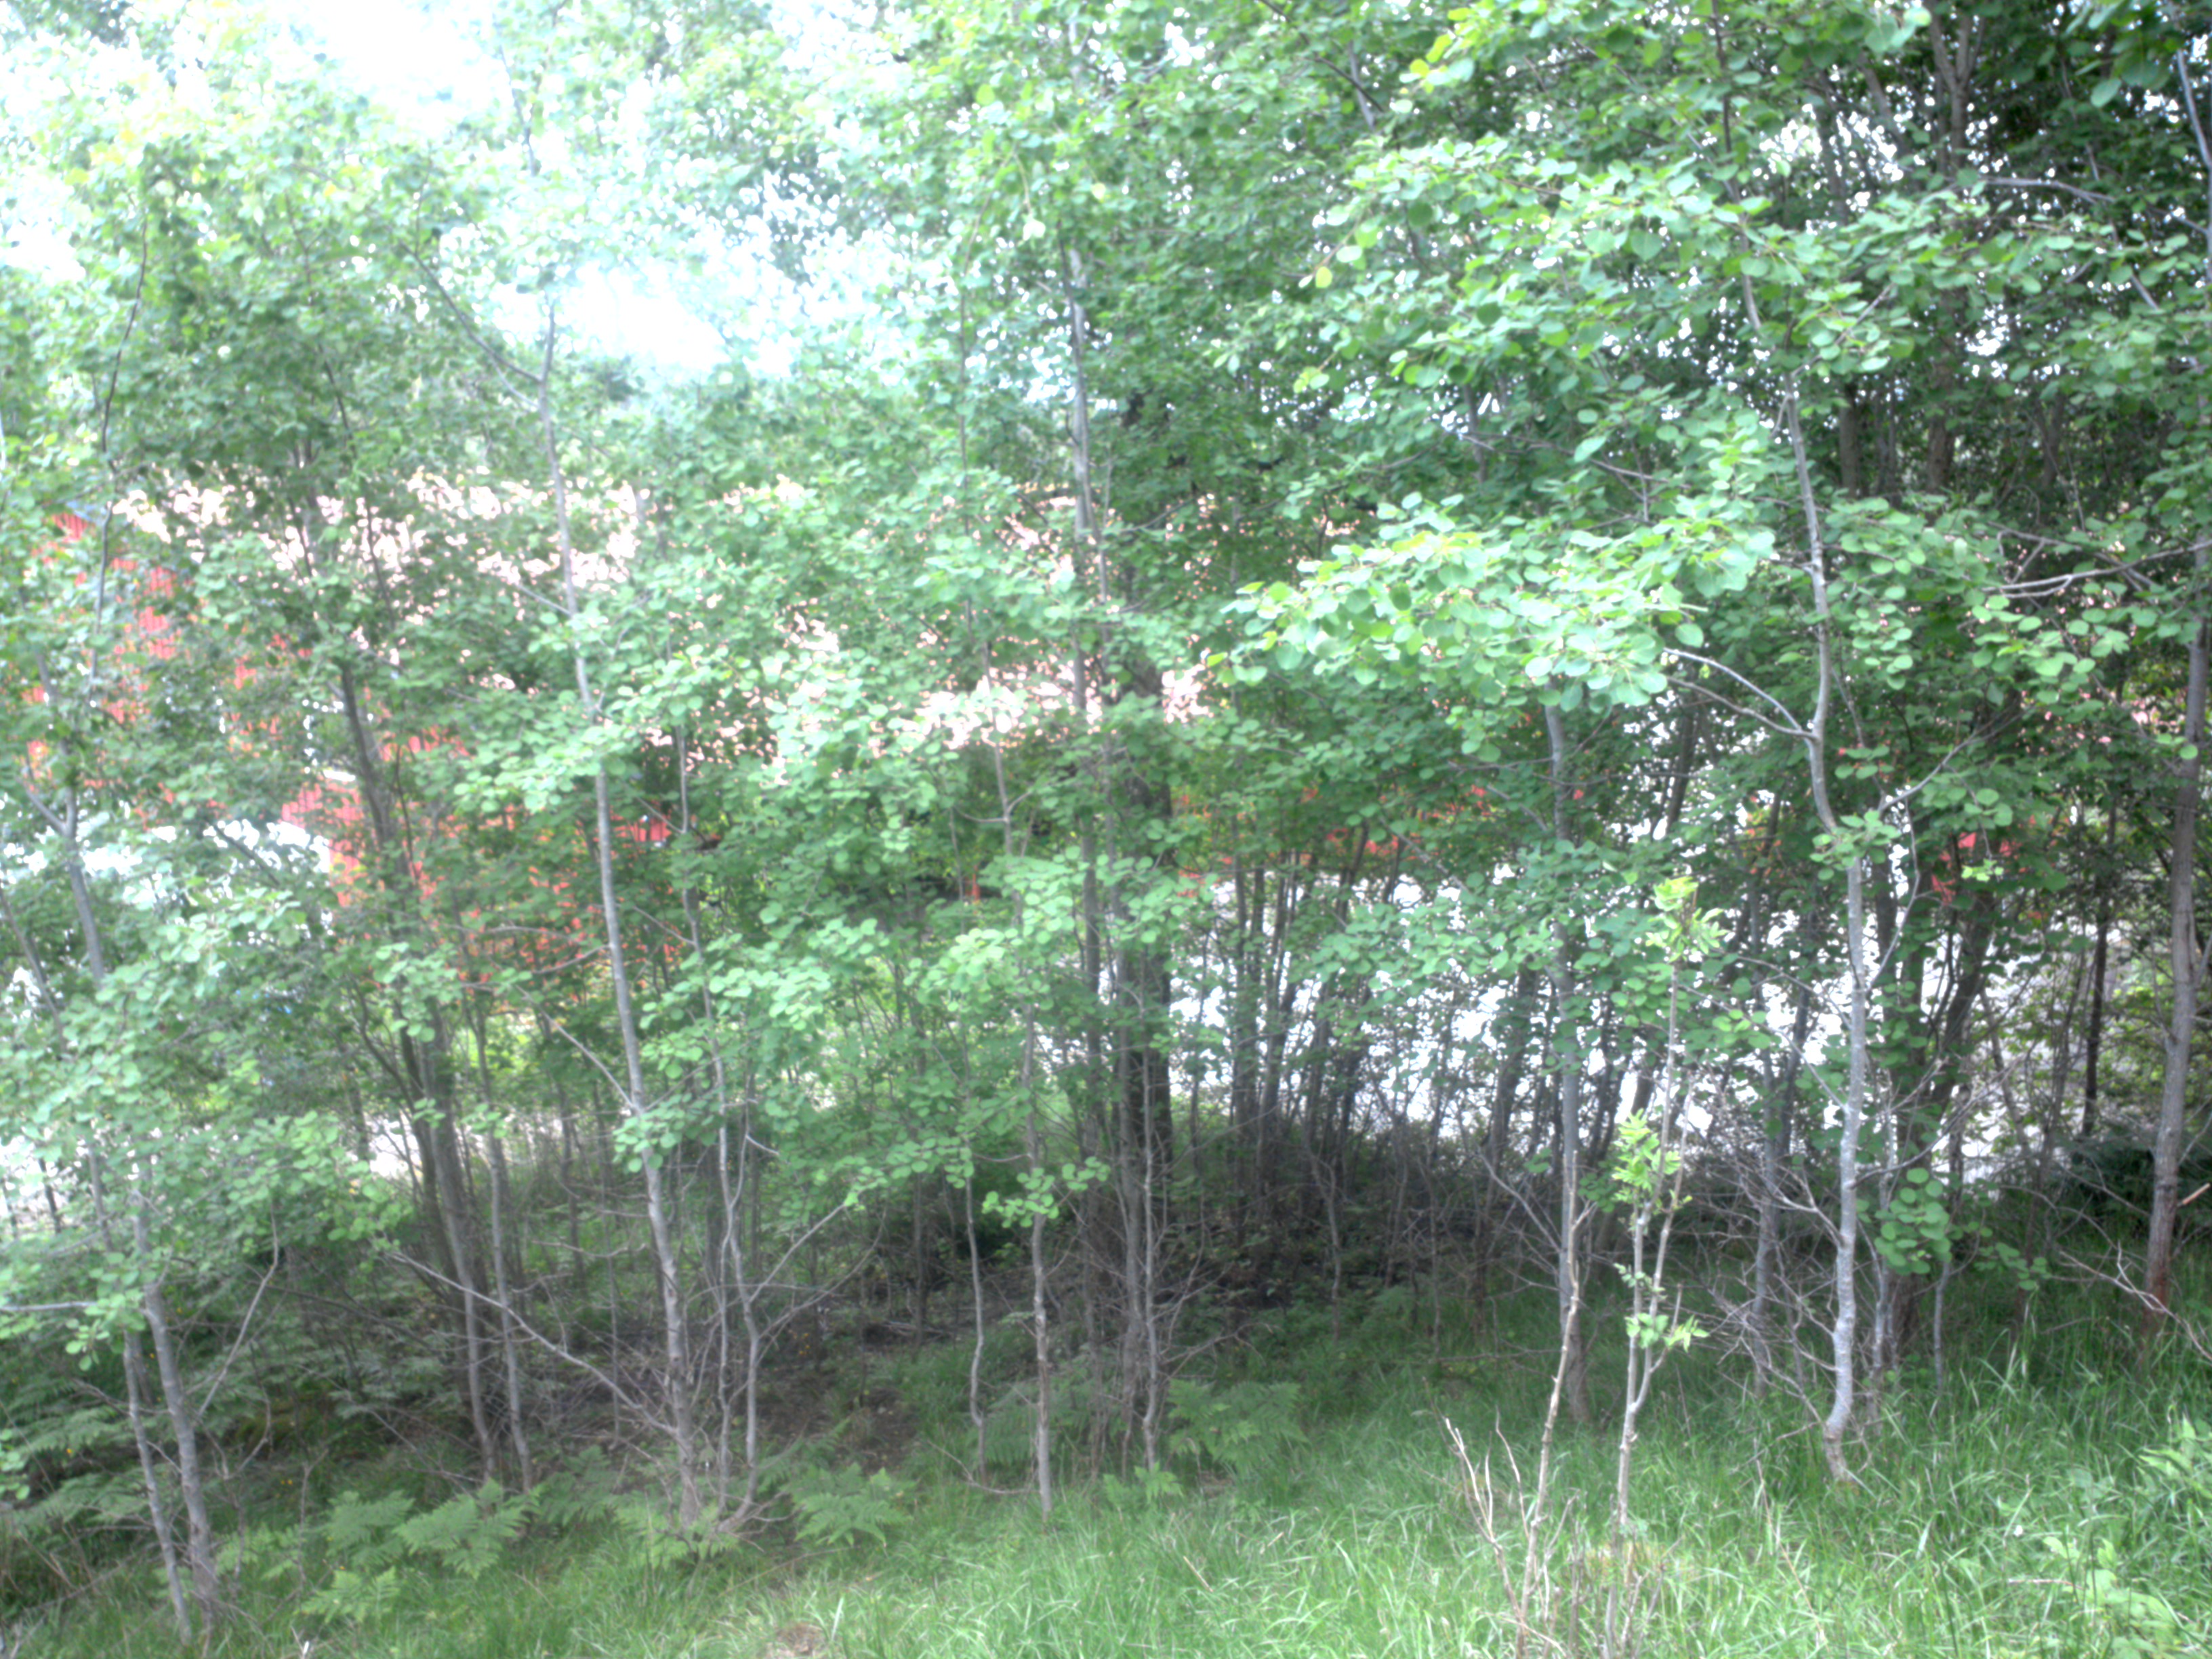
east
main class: Woodland
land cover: Broadleaved woodland
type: hemiboreal forest and nemoral coniferous forest and mixed broadleaved-coniferous forest
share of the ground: 10 - 25 %
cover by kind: herbaceous plants 80 %, broadleaved forest trees 20 %
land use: Semi-natural and natural areas not in use
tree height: > 5 m
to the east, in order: Broadleaved woodland; Artificial constructions in urban areas; Lines of trees; Grassland without tree/shrub cover; Fences; Grassland without tree/shrub cover; Fences; Grassland without tree/shrub cover; Fences; Grassland without tree/shrub cover; Fences; Grassland without tree/shrub cover; Fences; Grassland without tree/shrub cover; Fences; Grassland without tree/shrub cover; Ditches and canals; Paved roads, cycling and walking lanes
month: June
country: SE
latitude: 59.2487
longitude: 17.6596
